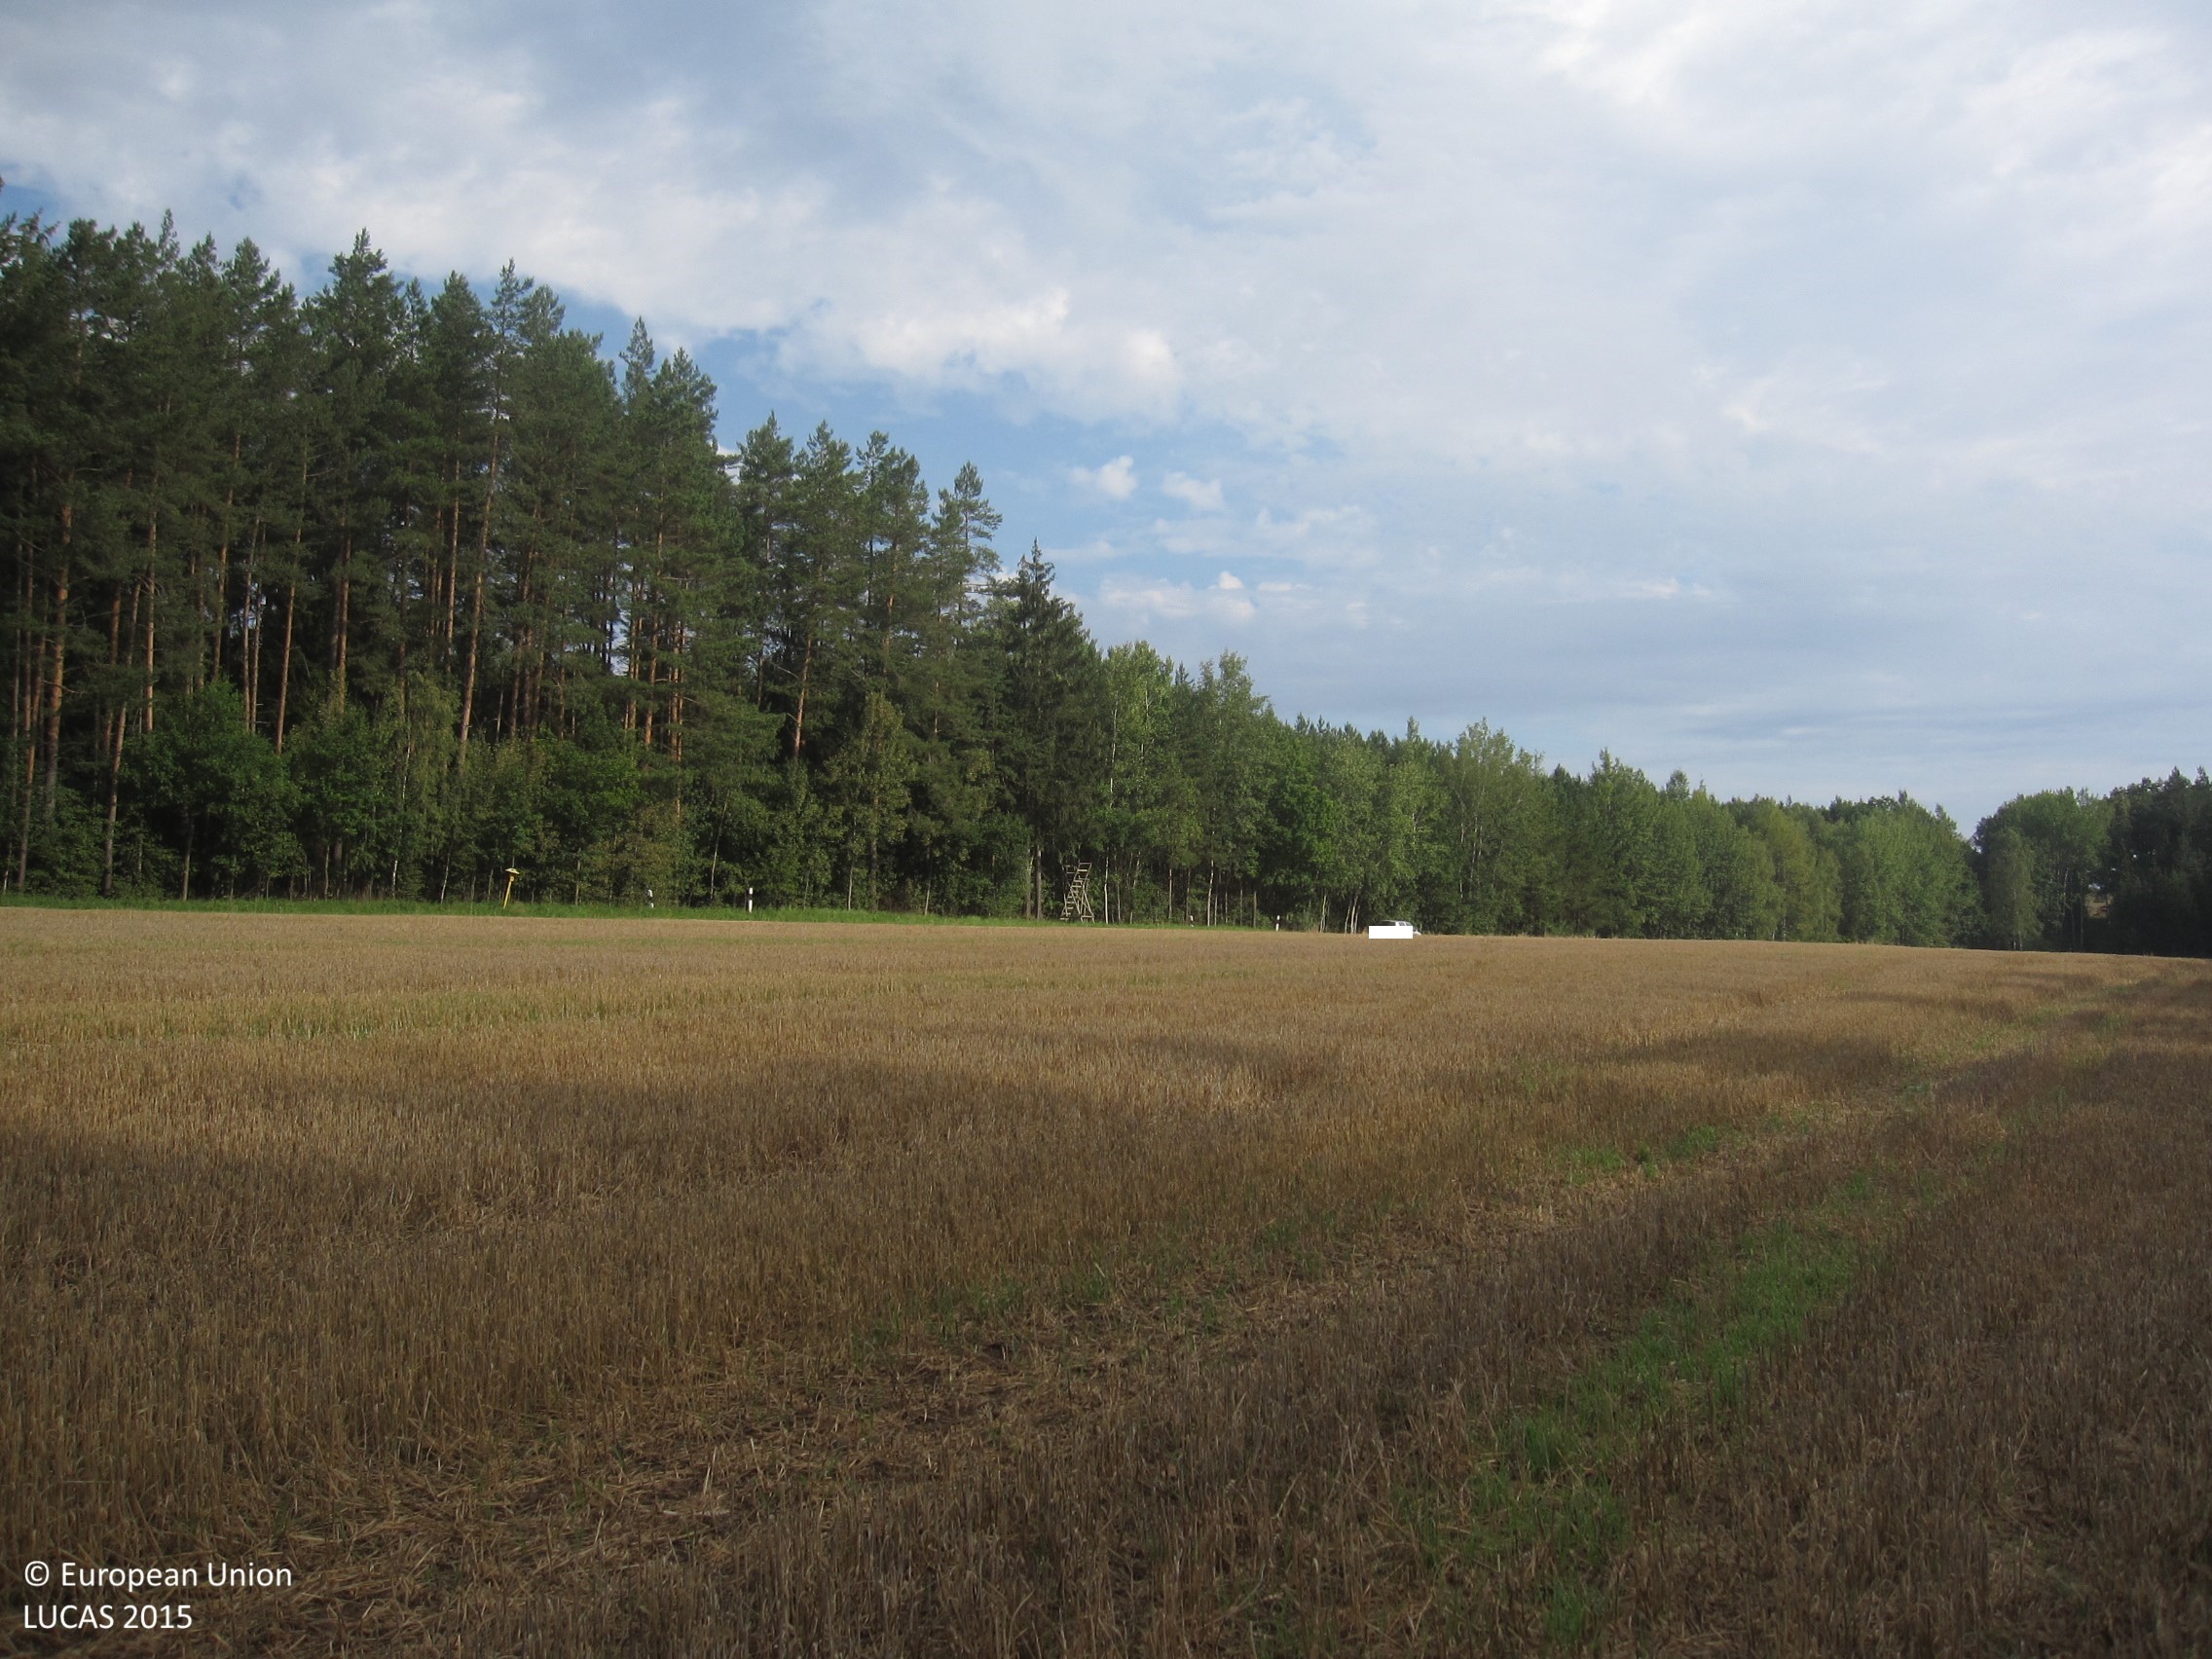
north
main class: Cropland
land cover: Common wheat
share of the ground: 50 - 75 %
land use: Agriculture (excluding fallow land and kitchen gardens)
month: August
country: DE
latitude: 50.7962
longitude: 12.0001
